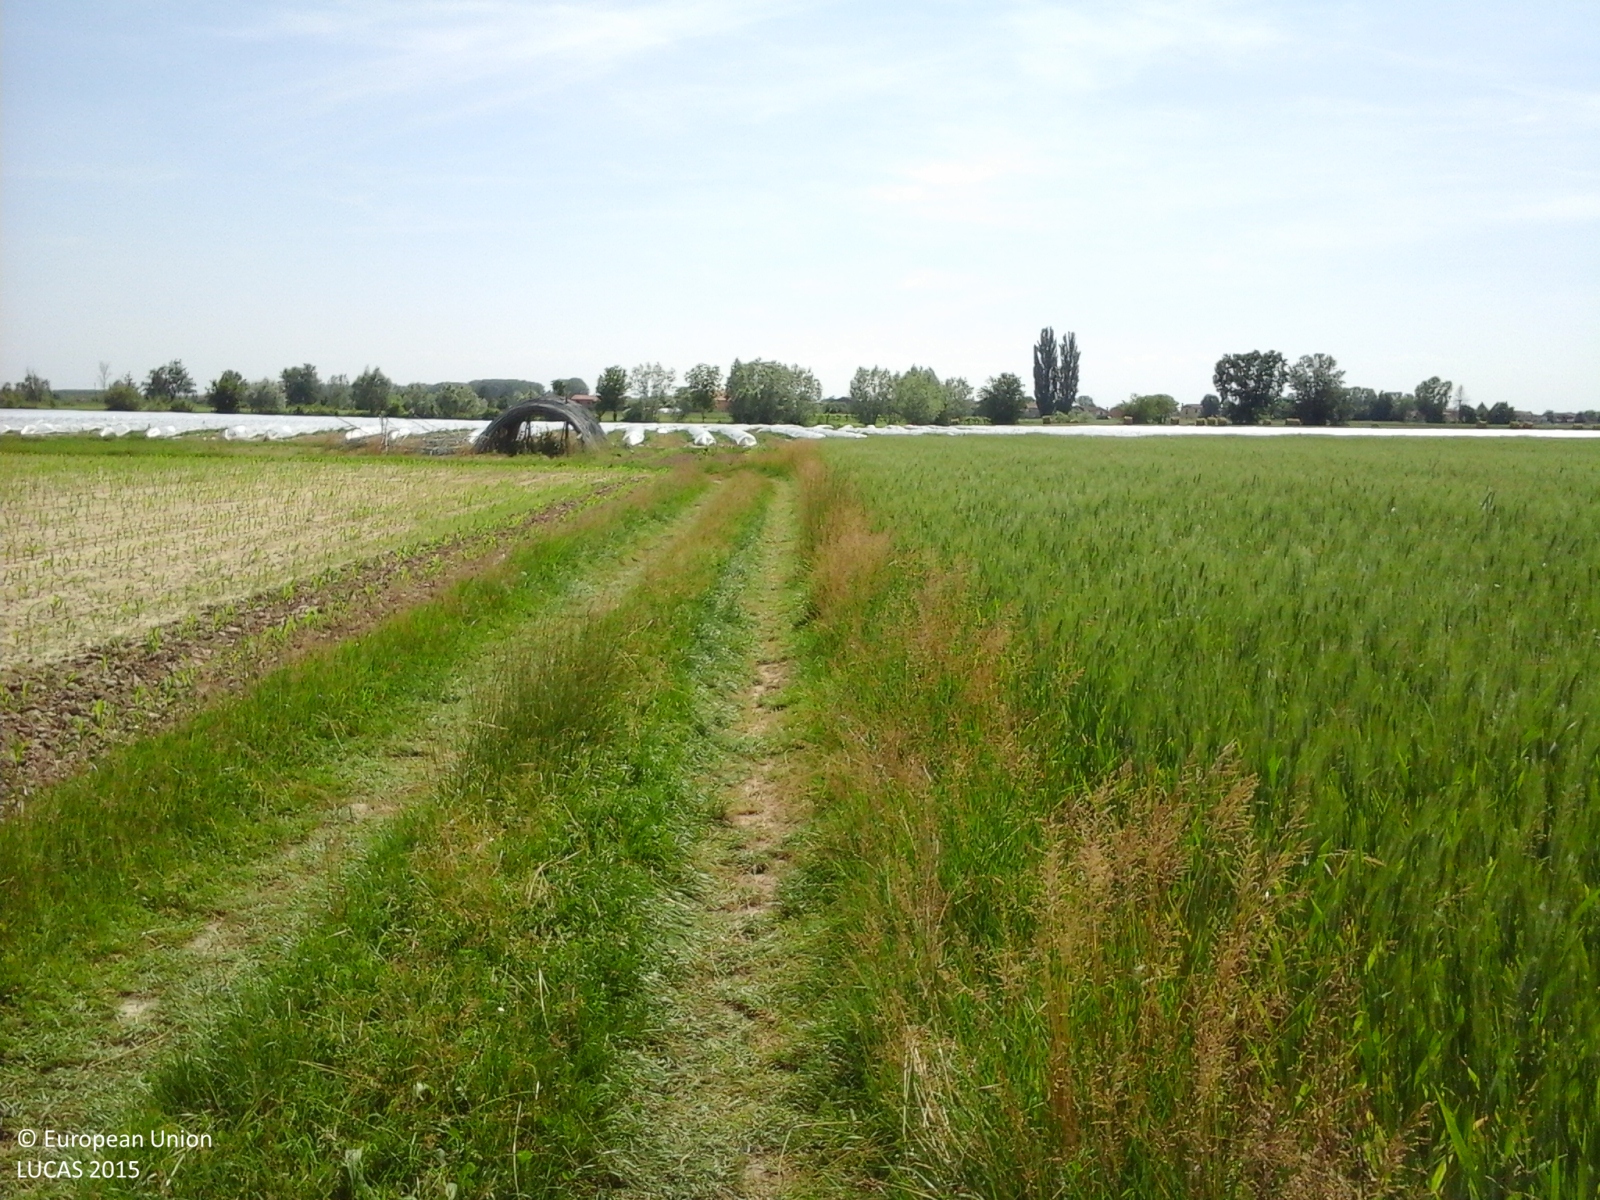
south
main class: Cropland
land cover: Common wheat
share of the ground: > 75 %
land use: Agriculture (excluding fallow land and kitchen gardens)
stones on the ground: < 10 %
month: May
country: IT
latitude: 44.9441
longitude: 10.5692
